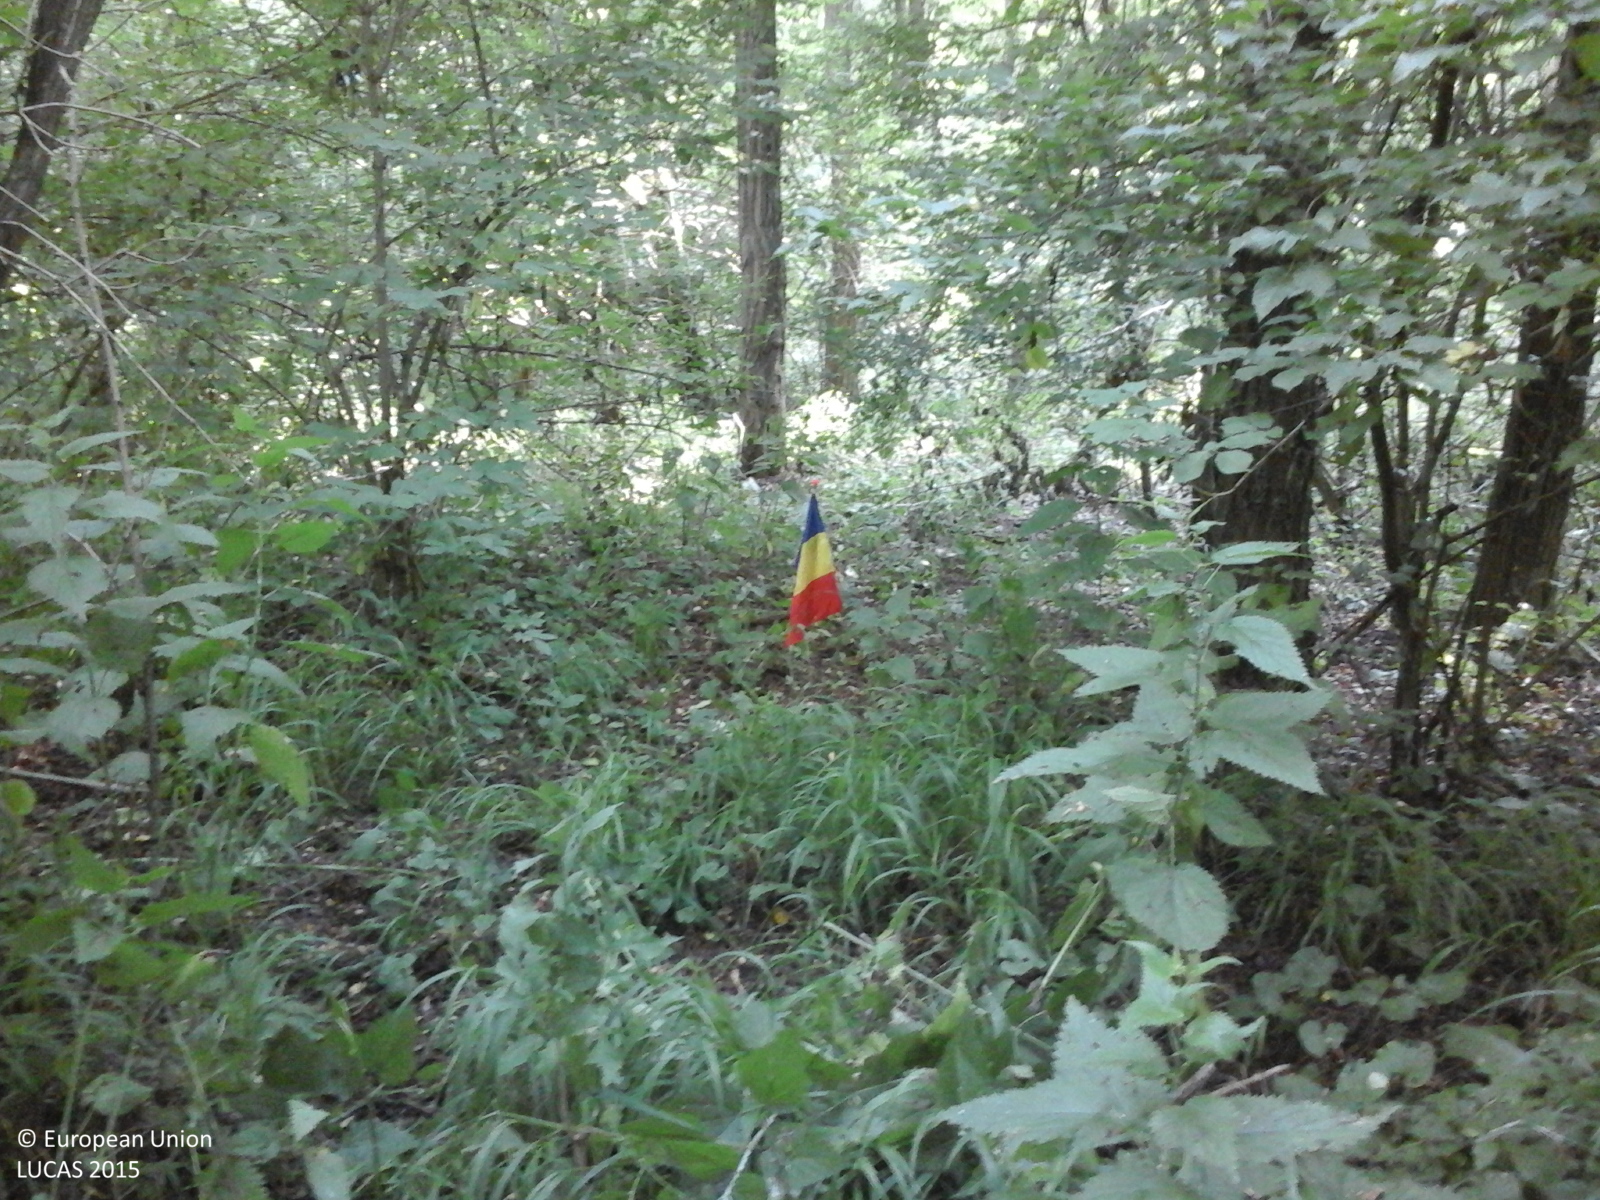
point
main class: Woodland
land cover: Broadleaved woodland
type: exotic forest
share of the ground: > 75 %
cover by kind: broadleaved forest trees 90 %, herbaceous plants 10 %
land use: Forestry
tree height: > 5 m
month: June
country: RO
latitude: 44.5256
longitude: 25.9178
